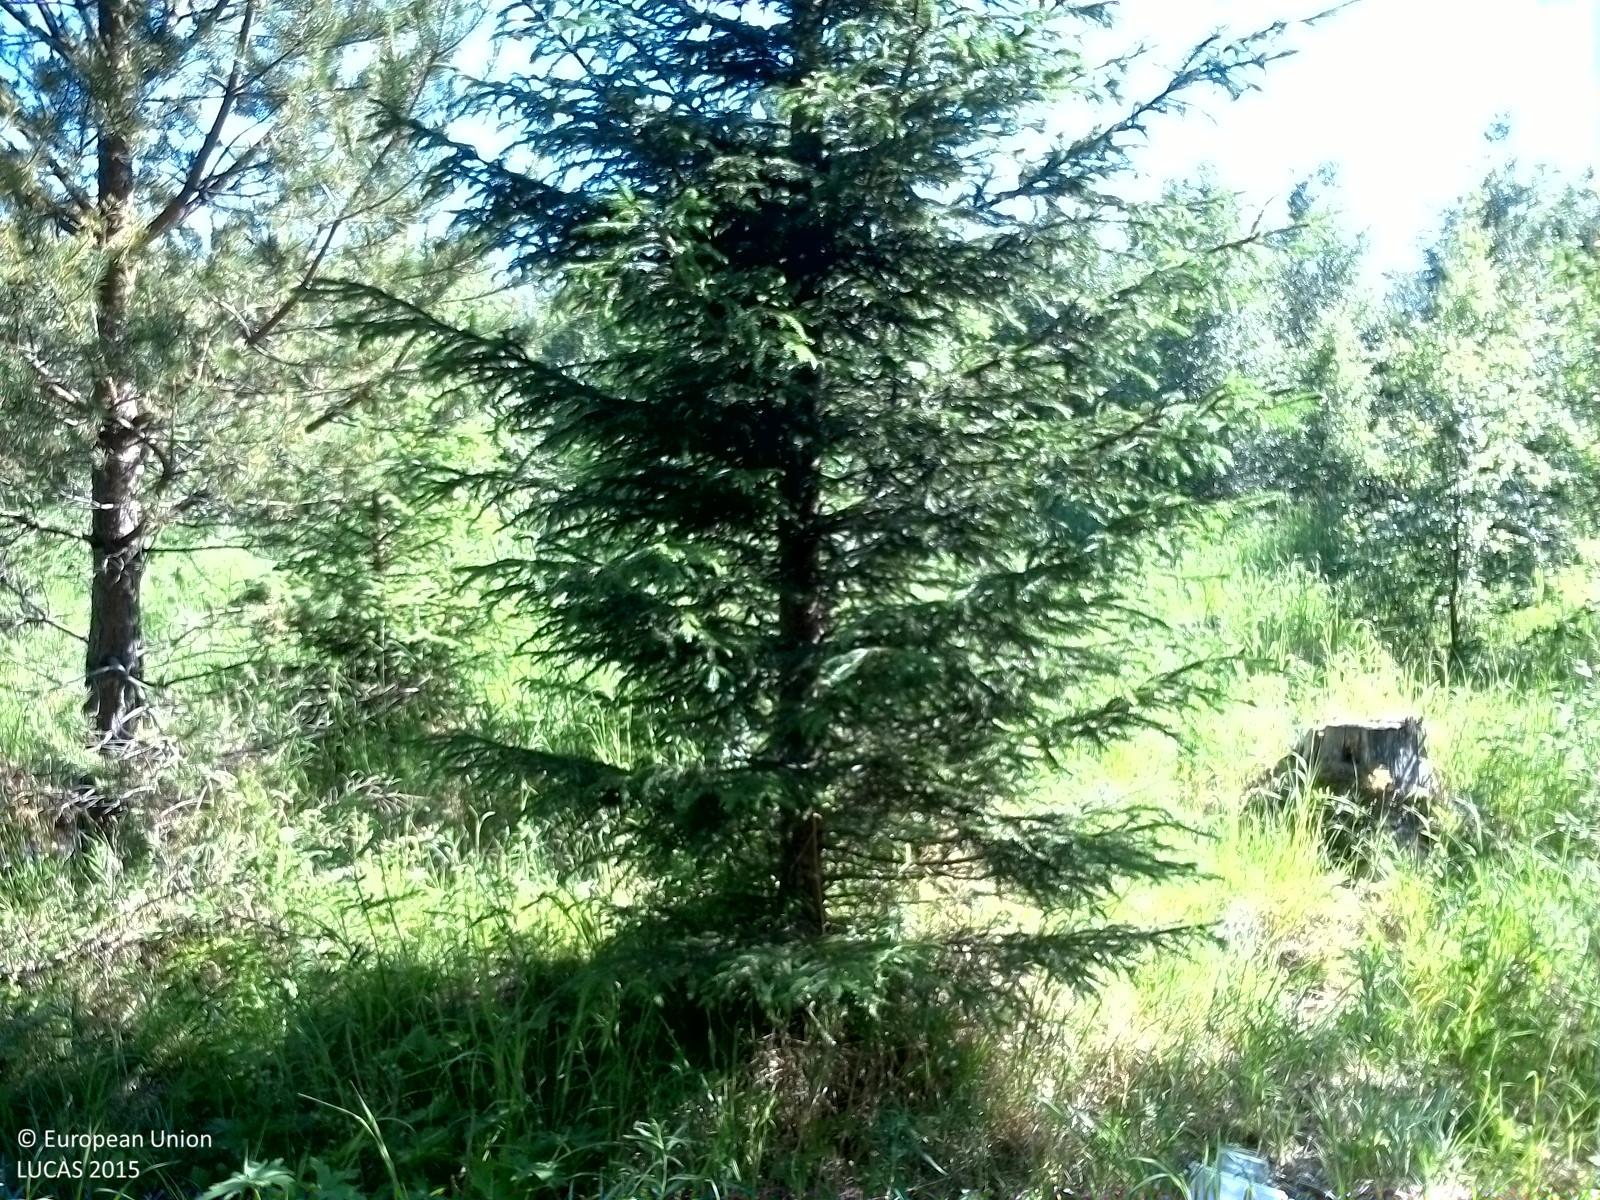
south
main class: Woodland
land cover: Spruce dominated coniferous woodland
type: boreal forest
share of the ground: 25 - 50 %
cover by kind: herbaceous plants 55 %, coniferous forest trees 45 %
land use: Forestry
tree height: > 5 m
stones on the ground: < 10 %
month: July
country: SE
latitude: 62.2177
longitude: 16.9234
